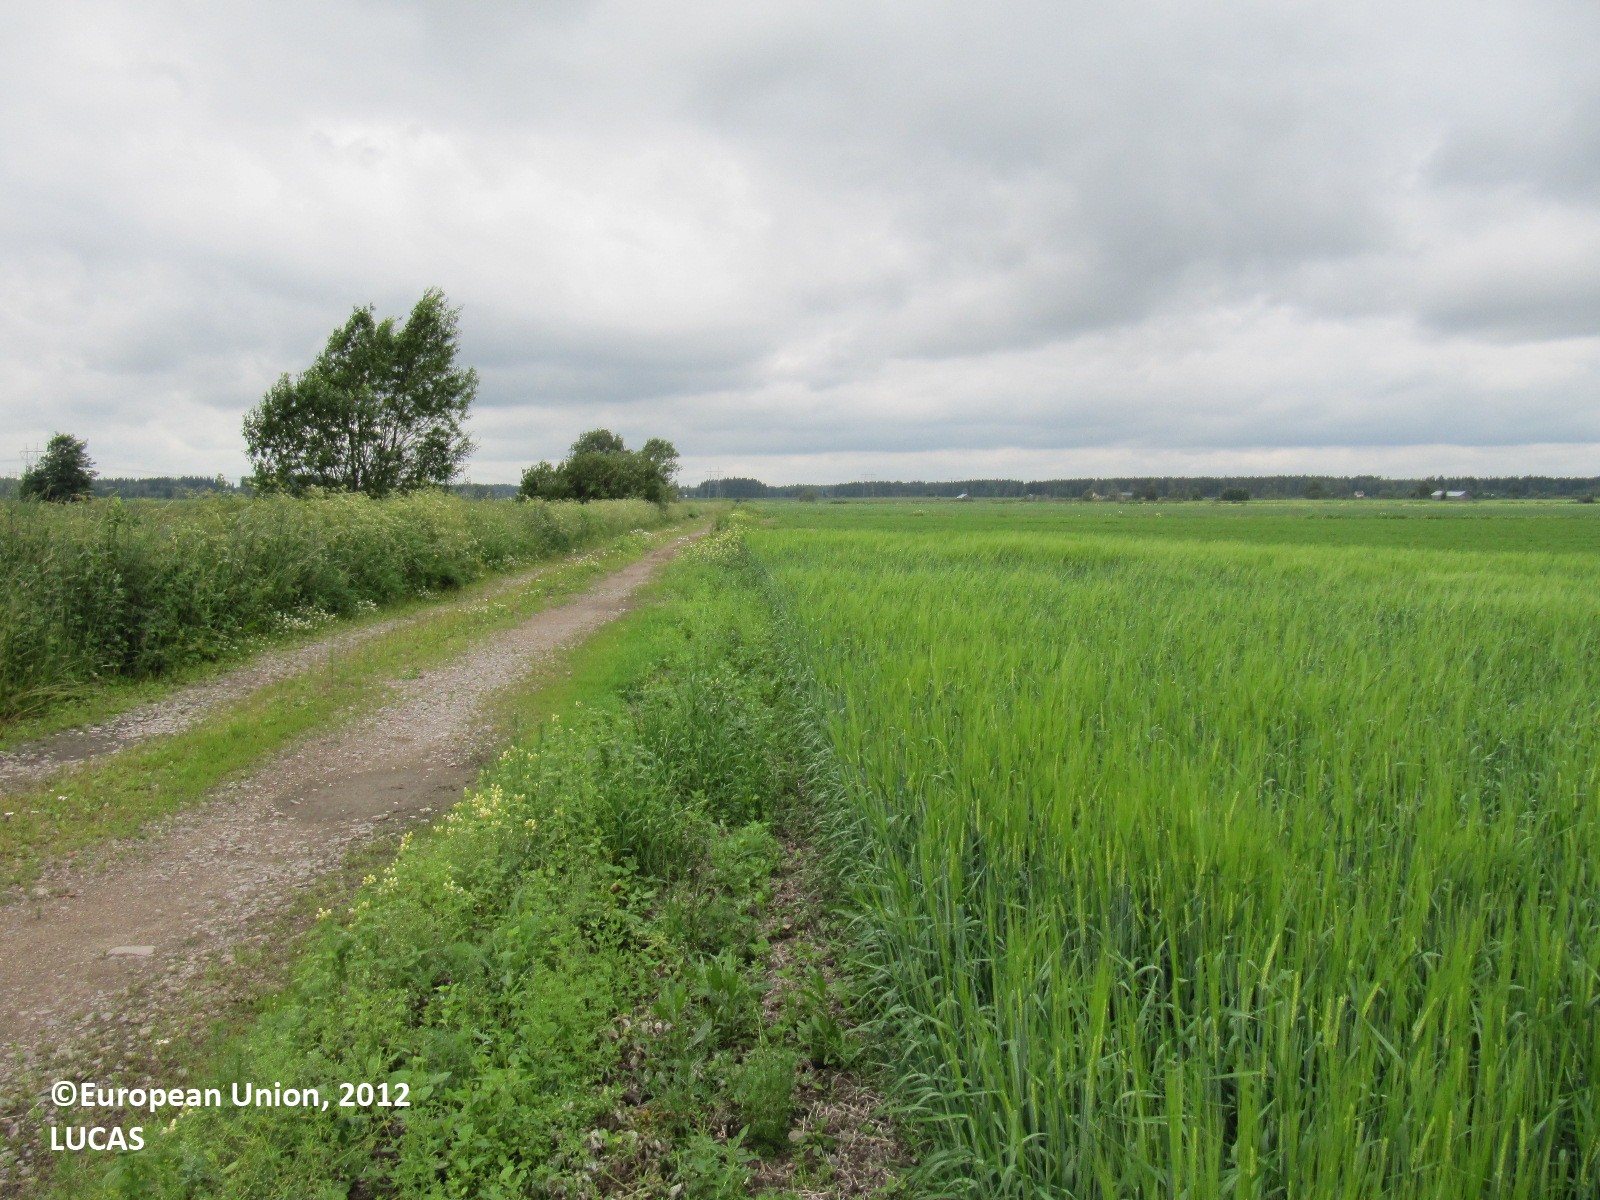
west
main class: Cropland
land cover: Barley
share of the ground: > 75 %
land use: Agriculture (excluding fallow land and kitchen gardens)
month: July
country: FI
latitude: 60.9192
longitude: 23.3047
